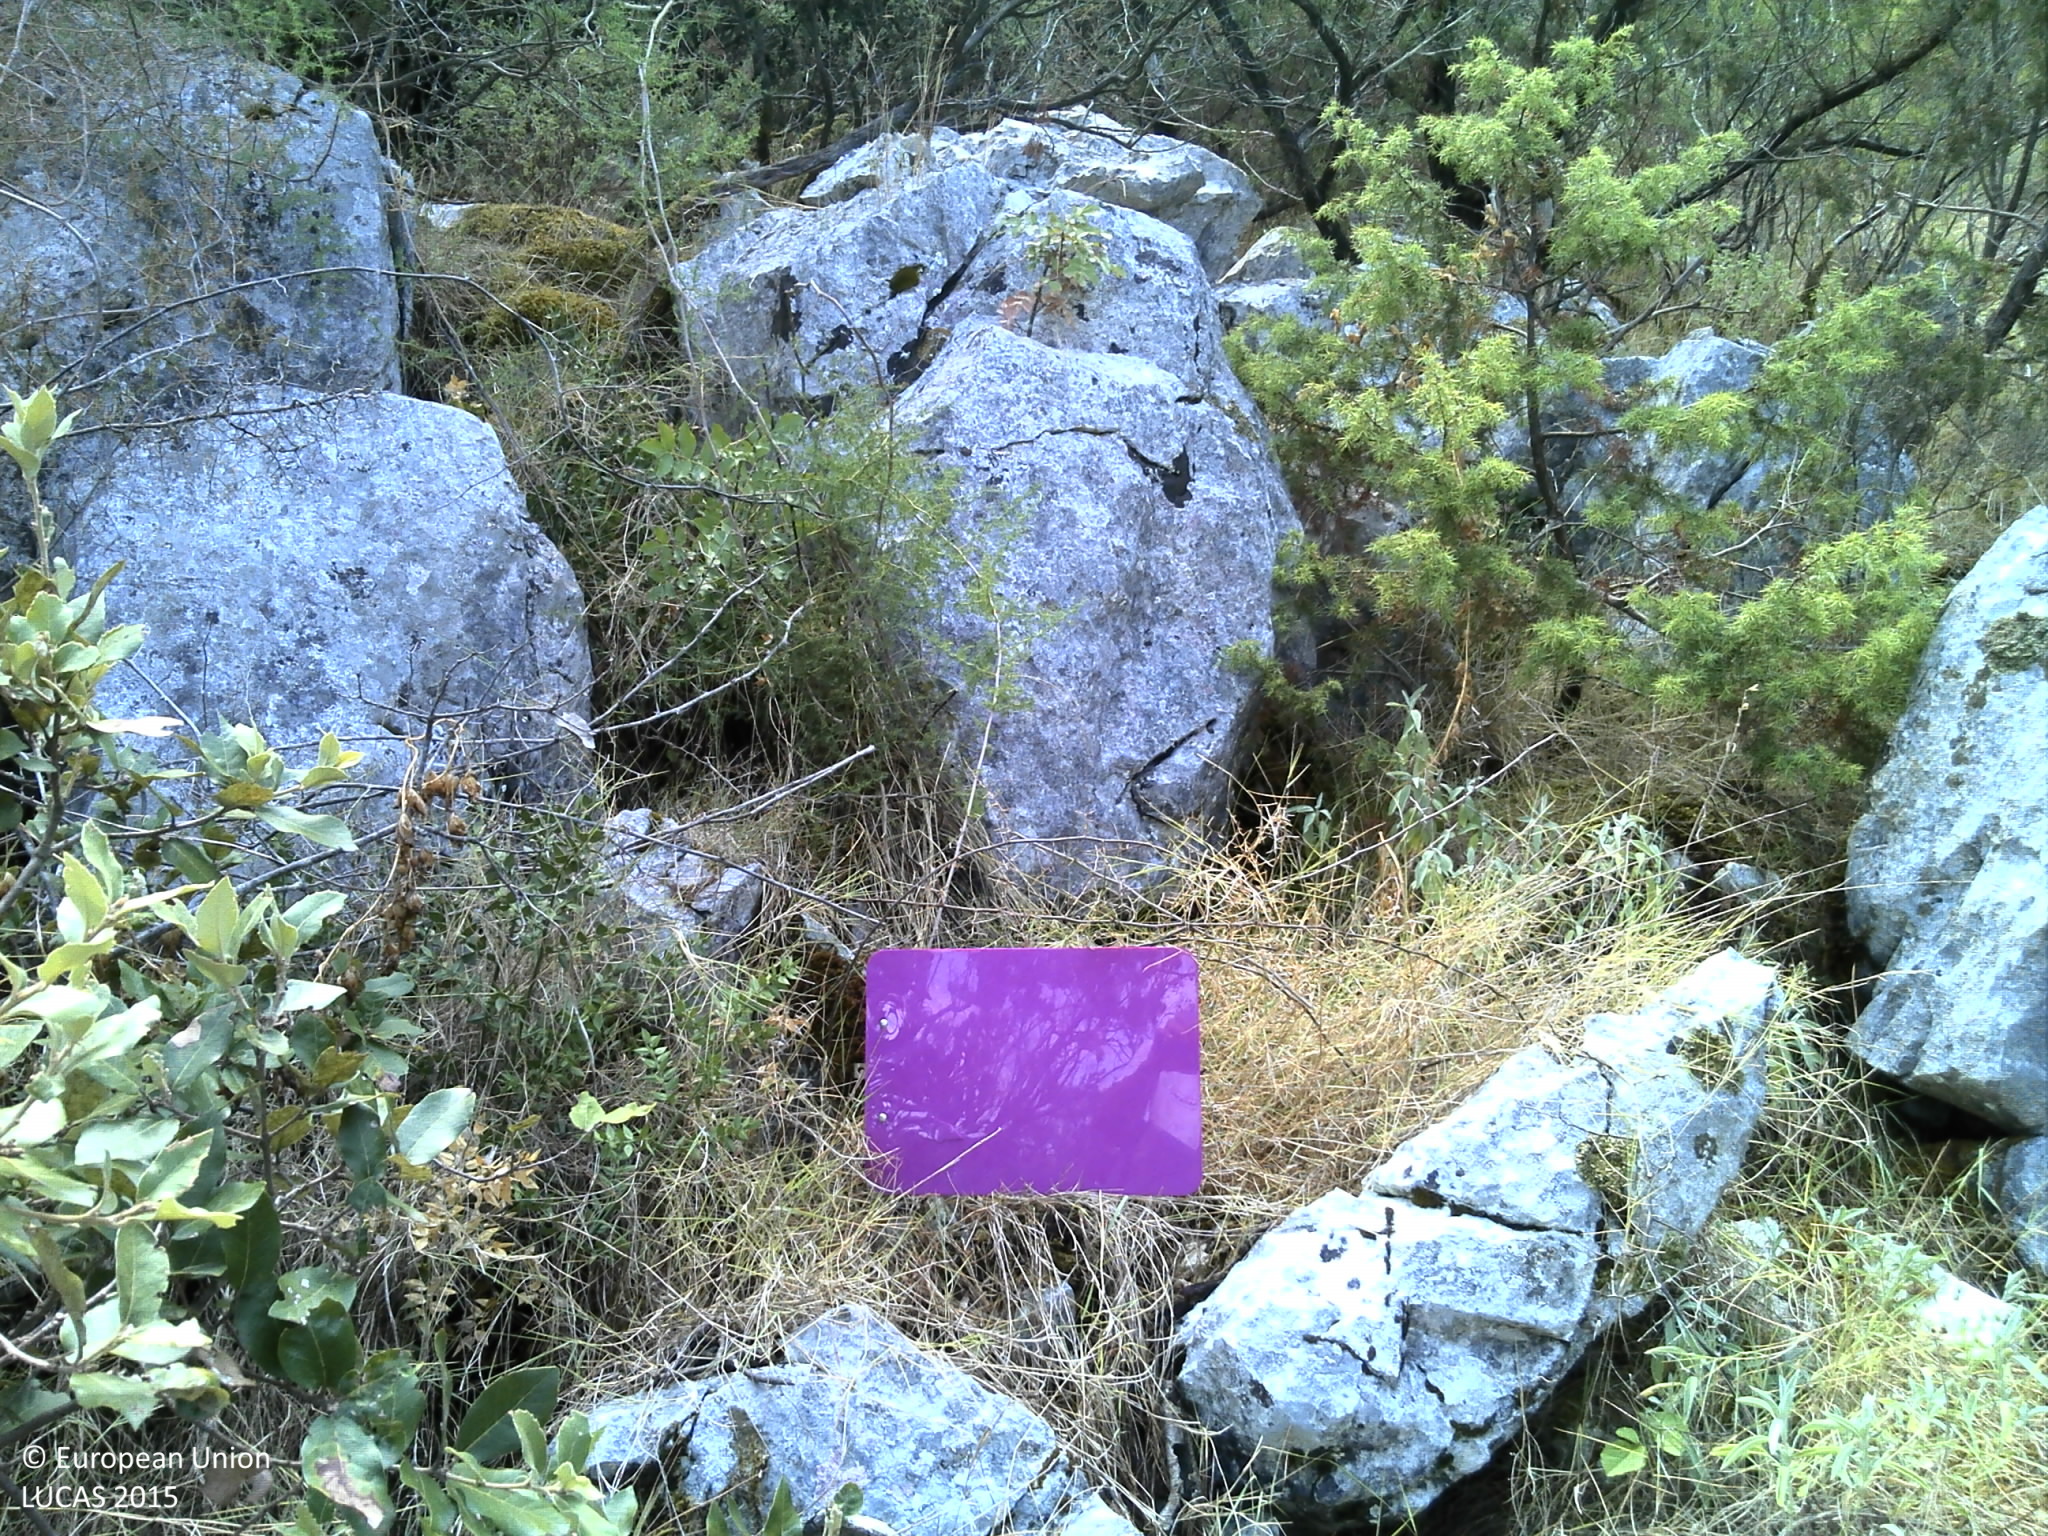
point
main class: Shrubland
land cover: Shrubland with sparse tree cover
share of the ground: > 75 %
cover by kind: shrubs 70 %, unconsolidated bare surface 10 %, broadleaved forest trees 5 %, herbaceous plants 5 %, lichens and mosses 5 %, consolidated bare surface 5 %
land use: Semi-natural and natural areas not in use
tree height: < 5 m
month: August
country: HR
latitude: 43.1357
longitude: 17.0098
